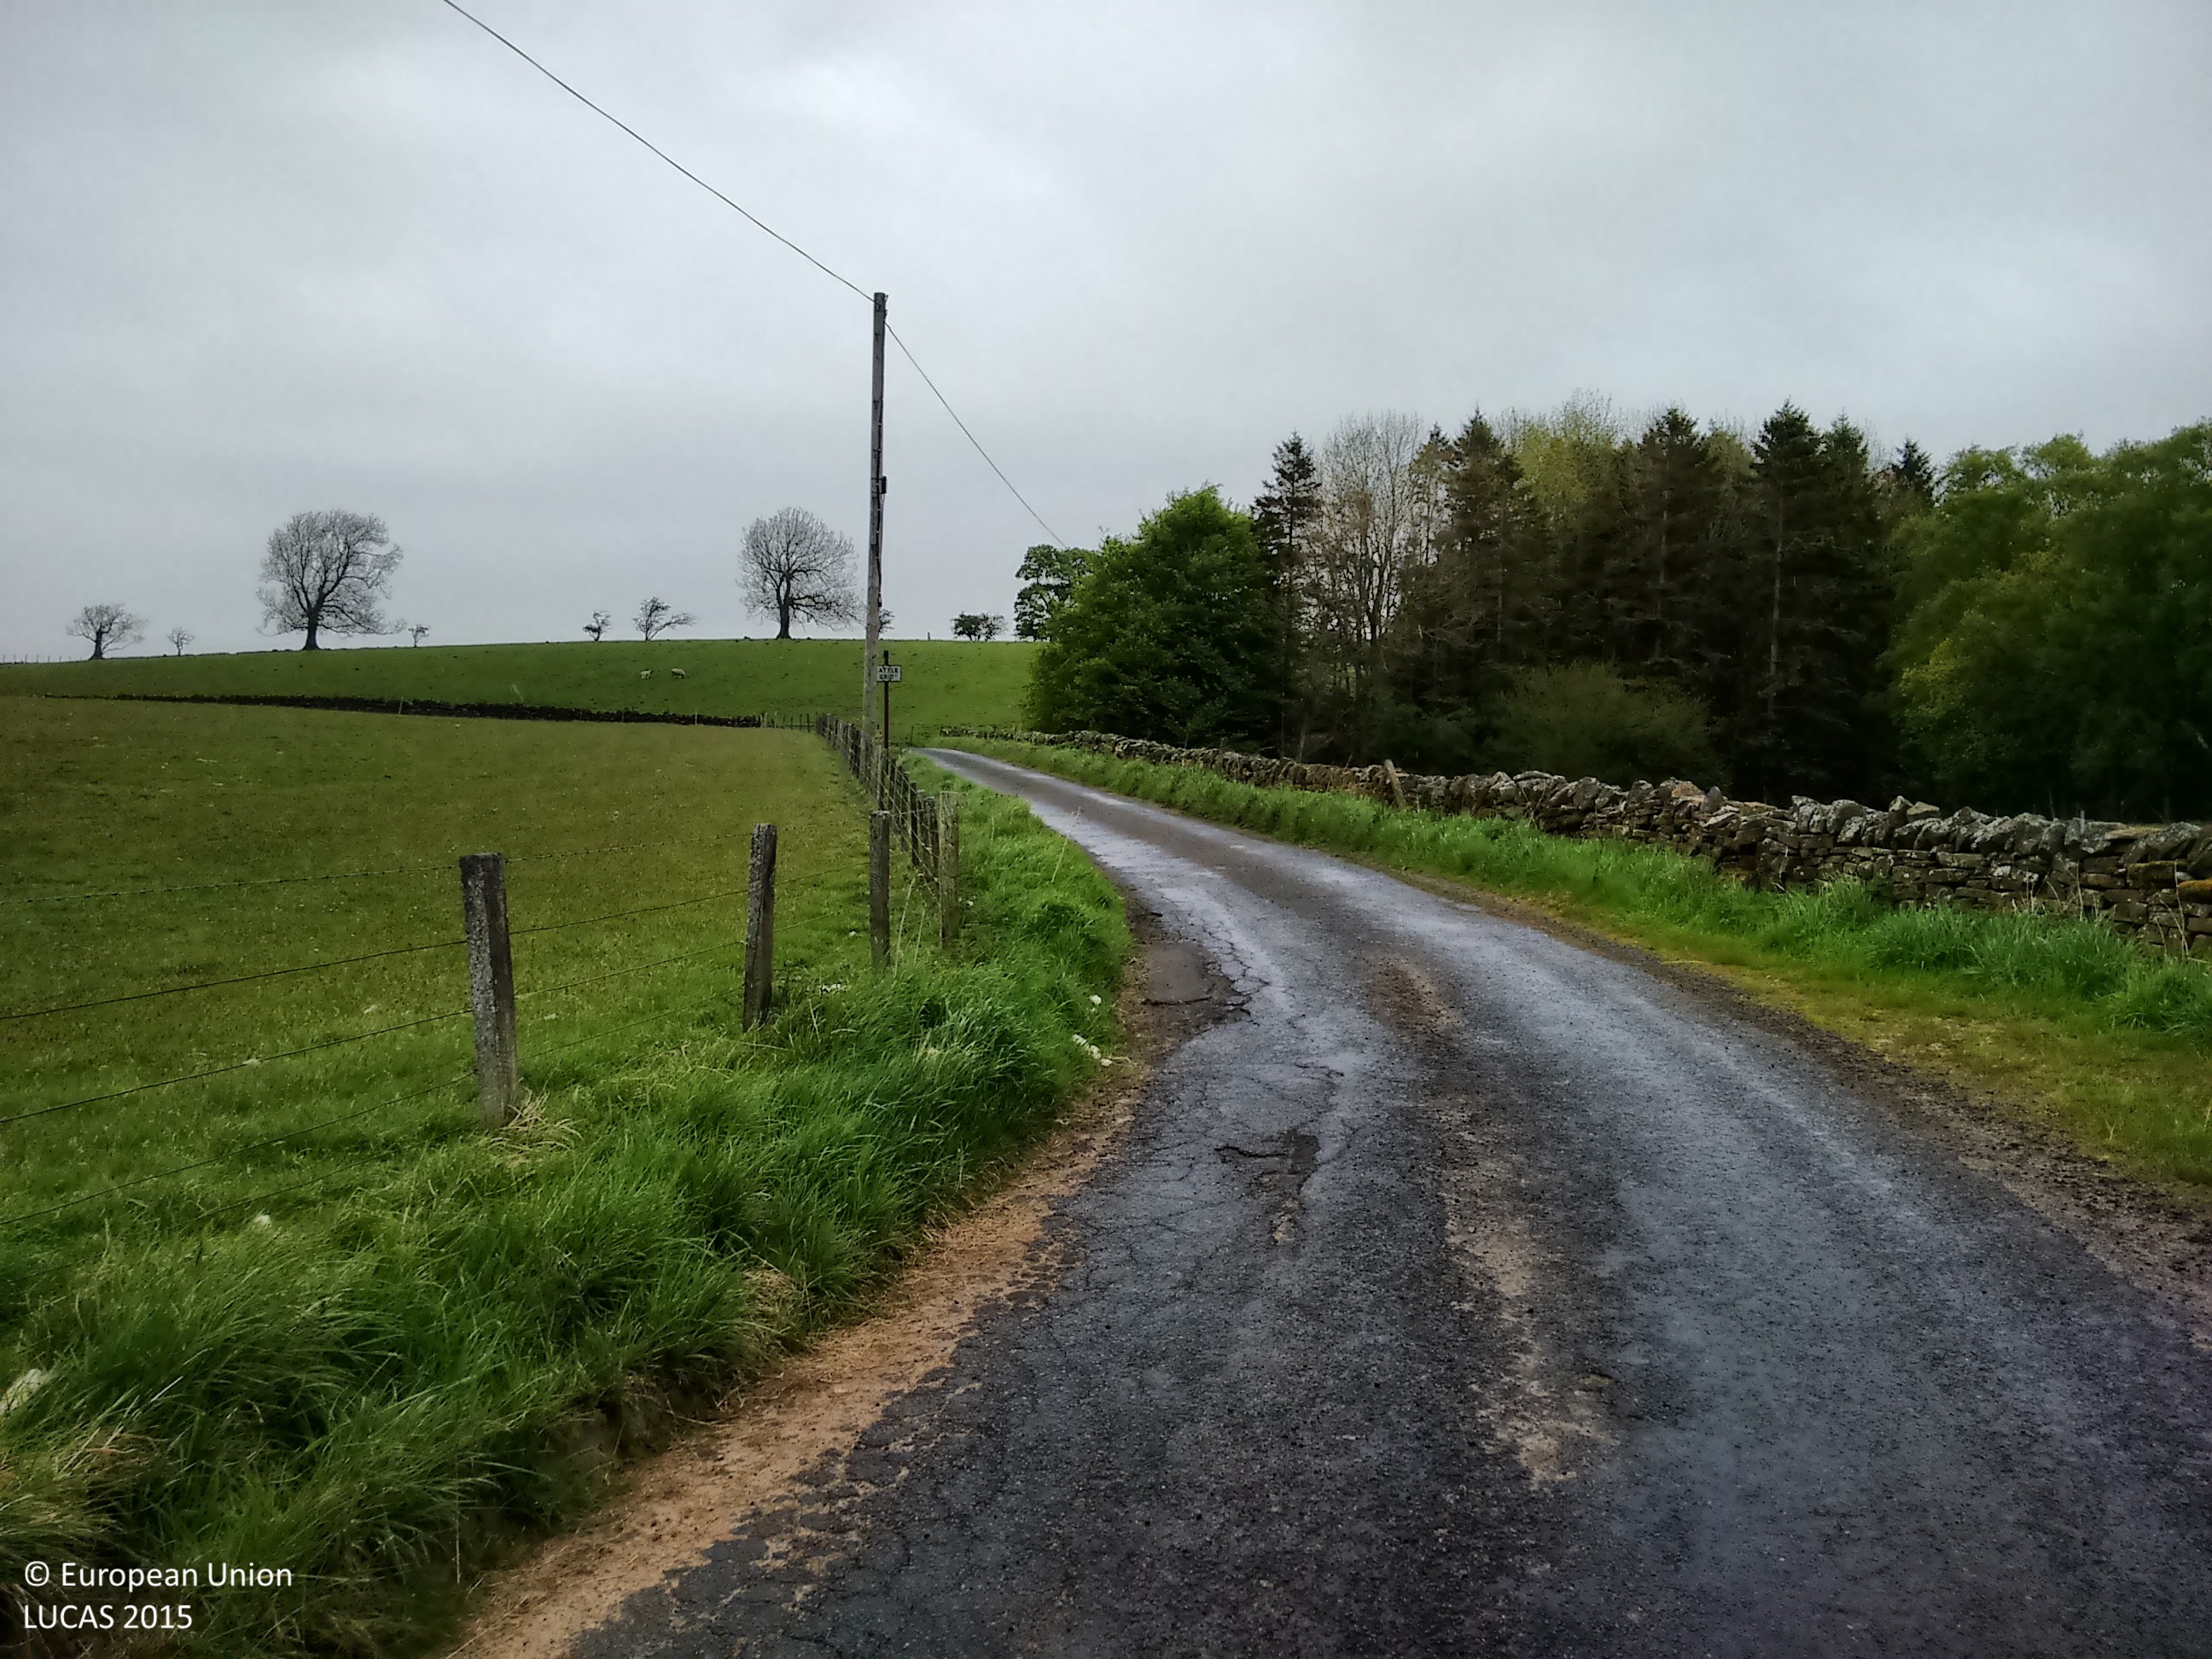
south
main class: Grassland
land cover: Grassland without tree/shrub cover
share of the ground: > 75 %
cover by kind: herbaceous plants 100 %
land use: Agriculture (excluding fallow land and kitchen gardens)
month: May
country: GB
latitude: 55.0517
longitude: -2.2522
